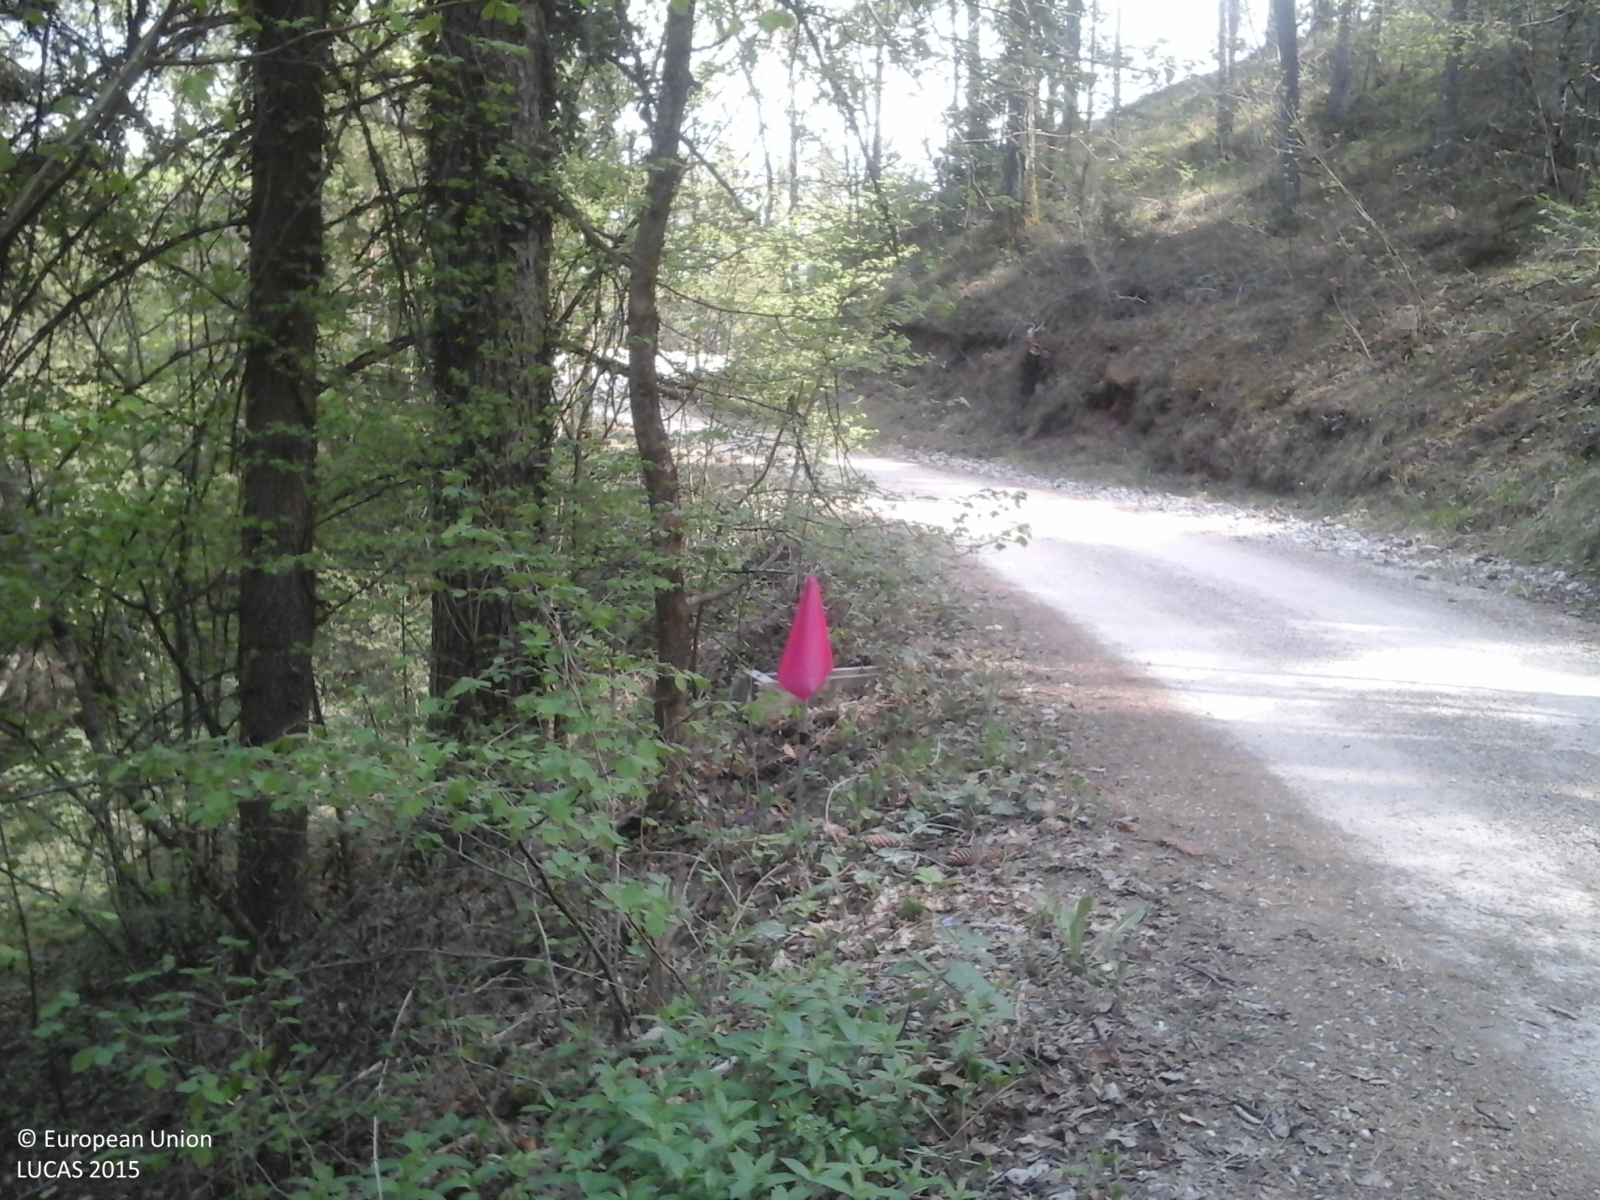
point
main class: Woodland
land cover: Other mixed woodland
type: mesophytic deciduous forest
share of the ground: > 75 %
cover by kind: coniferous forest trees 50 %, broadleaved forest trees 50 %
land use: Forestry
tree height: > 5 m
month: April
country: IT
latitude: 46.3635
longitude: 11.1034
